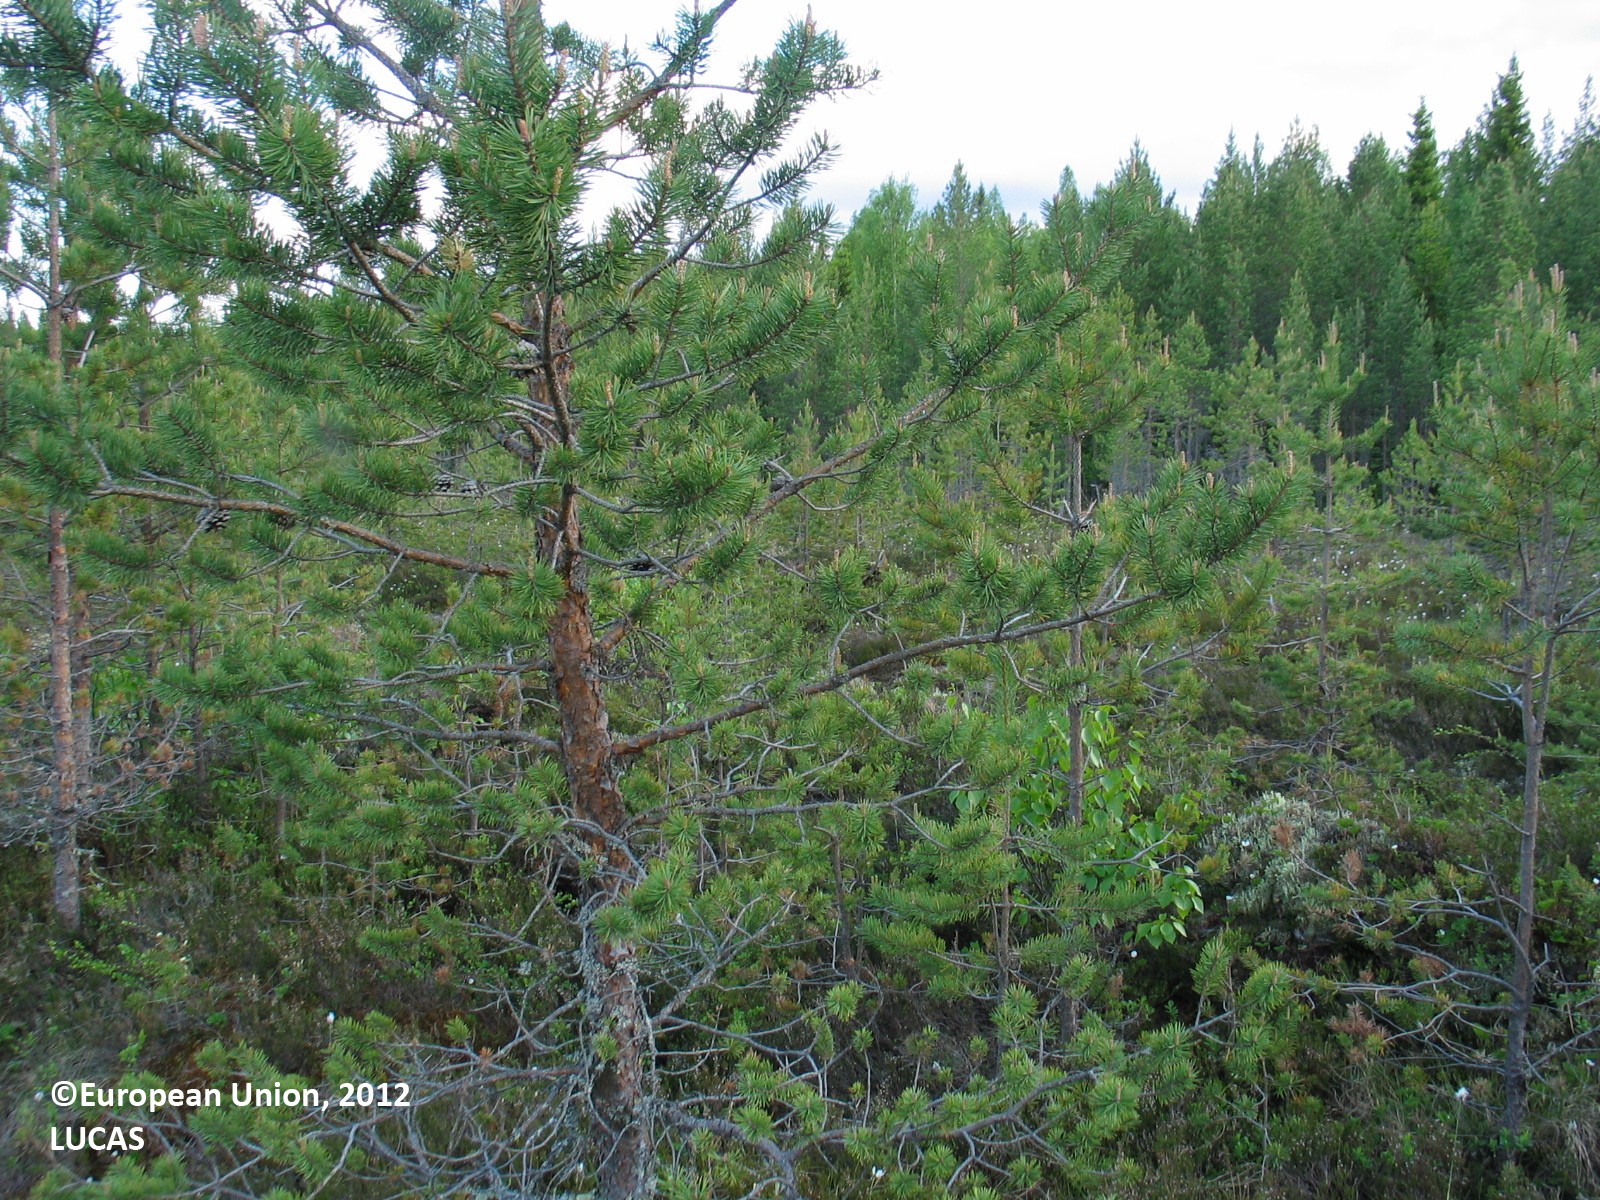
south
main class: Woodland
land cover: Pine dominated coniferous woodland
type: mire and swamp forests
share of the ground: 10 - 25 %
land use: Semi-natural and natural areas not in use
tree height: < 5 m
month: June
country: FI
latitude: 64.8606
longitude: 26.5022
